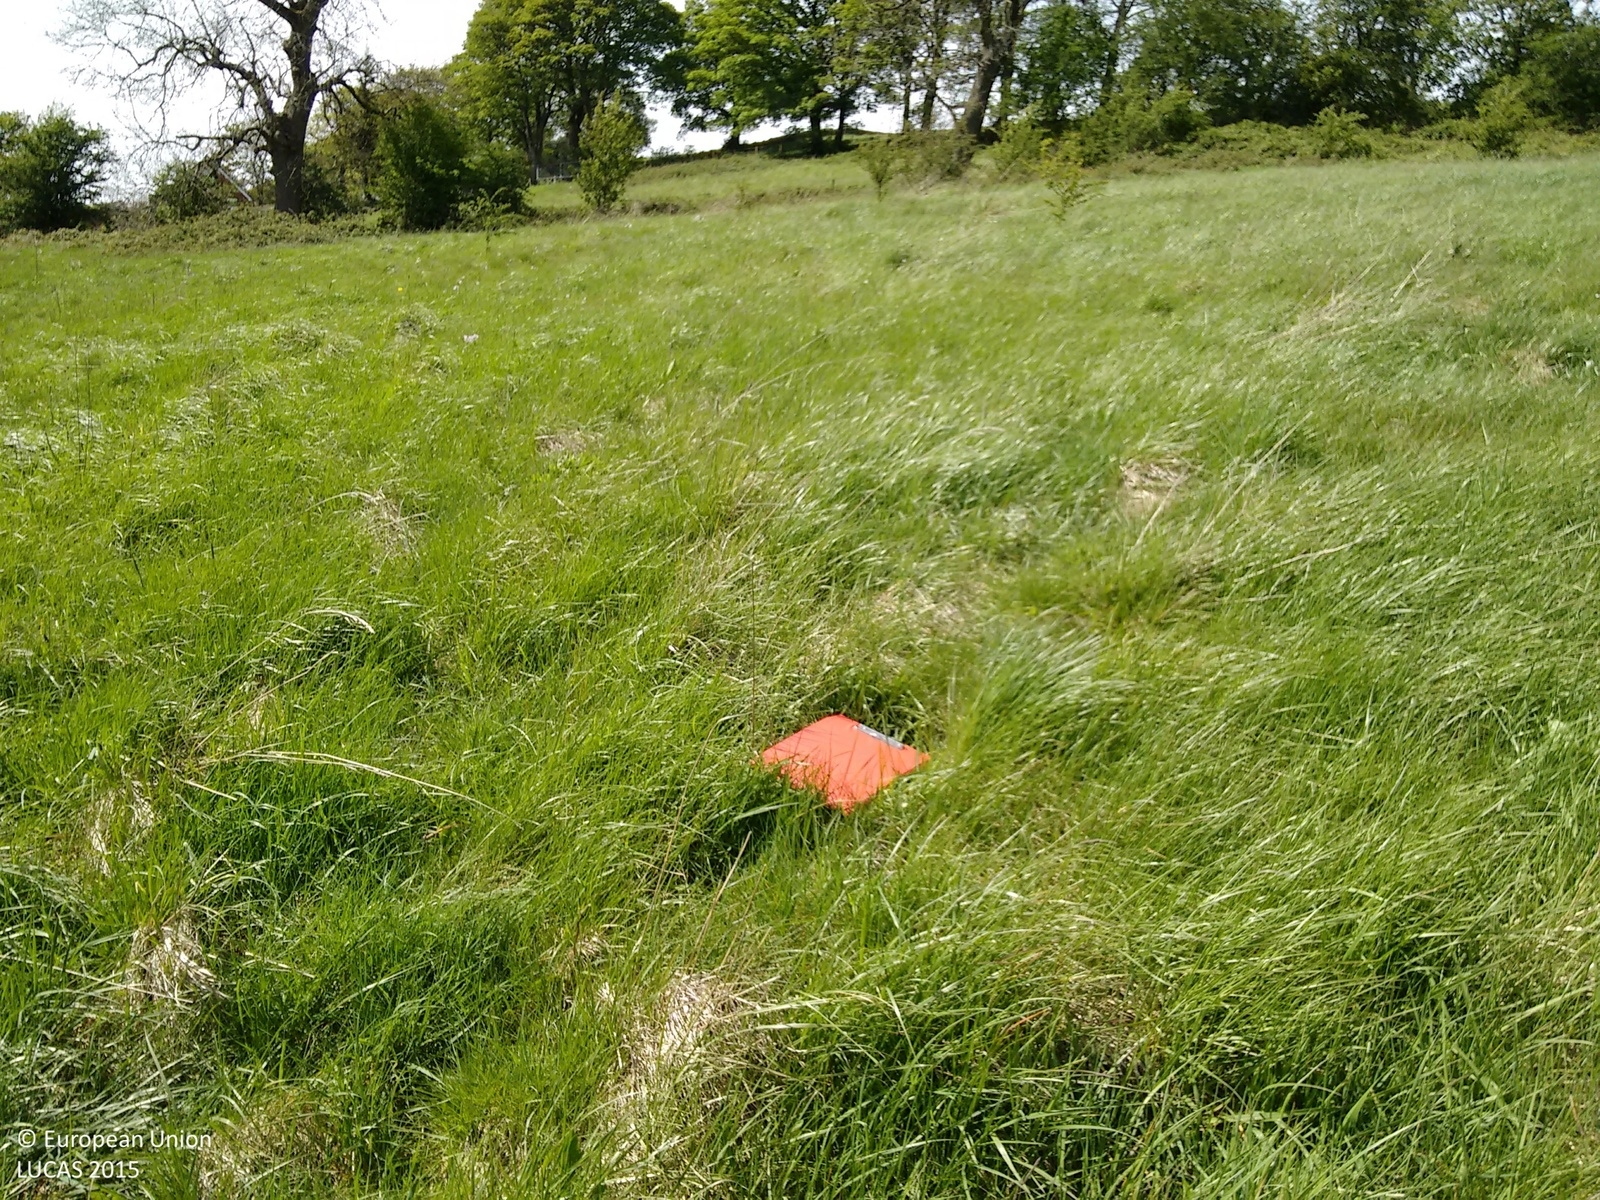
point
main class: Grassland
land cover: Grassland without tree/shrub cover
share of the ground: > 75 %
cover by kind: herbaceous plants 100 %
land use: Agriculture (excluding fallow land and kitchen gardens)
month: May
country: GB
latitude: 53.5869
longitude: -1.7919
